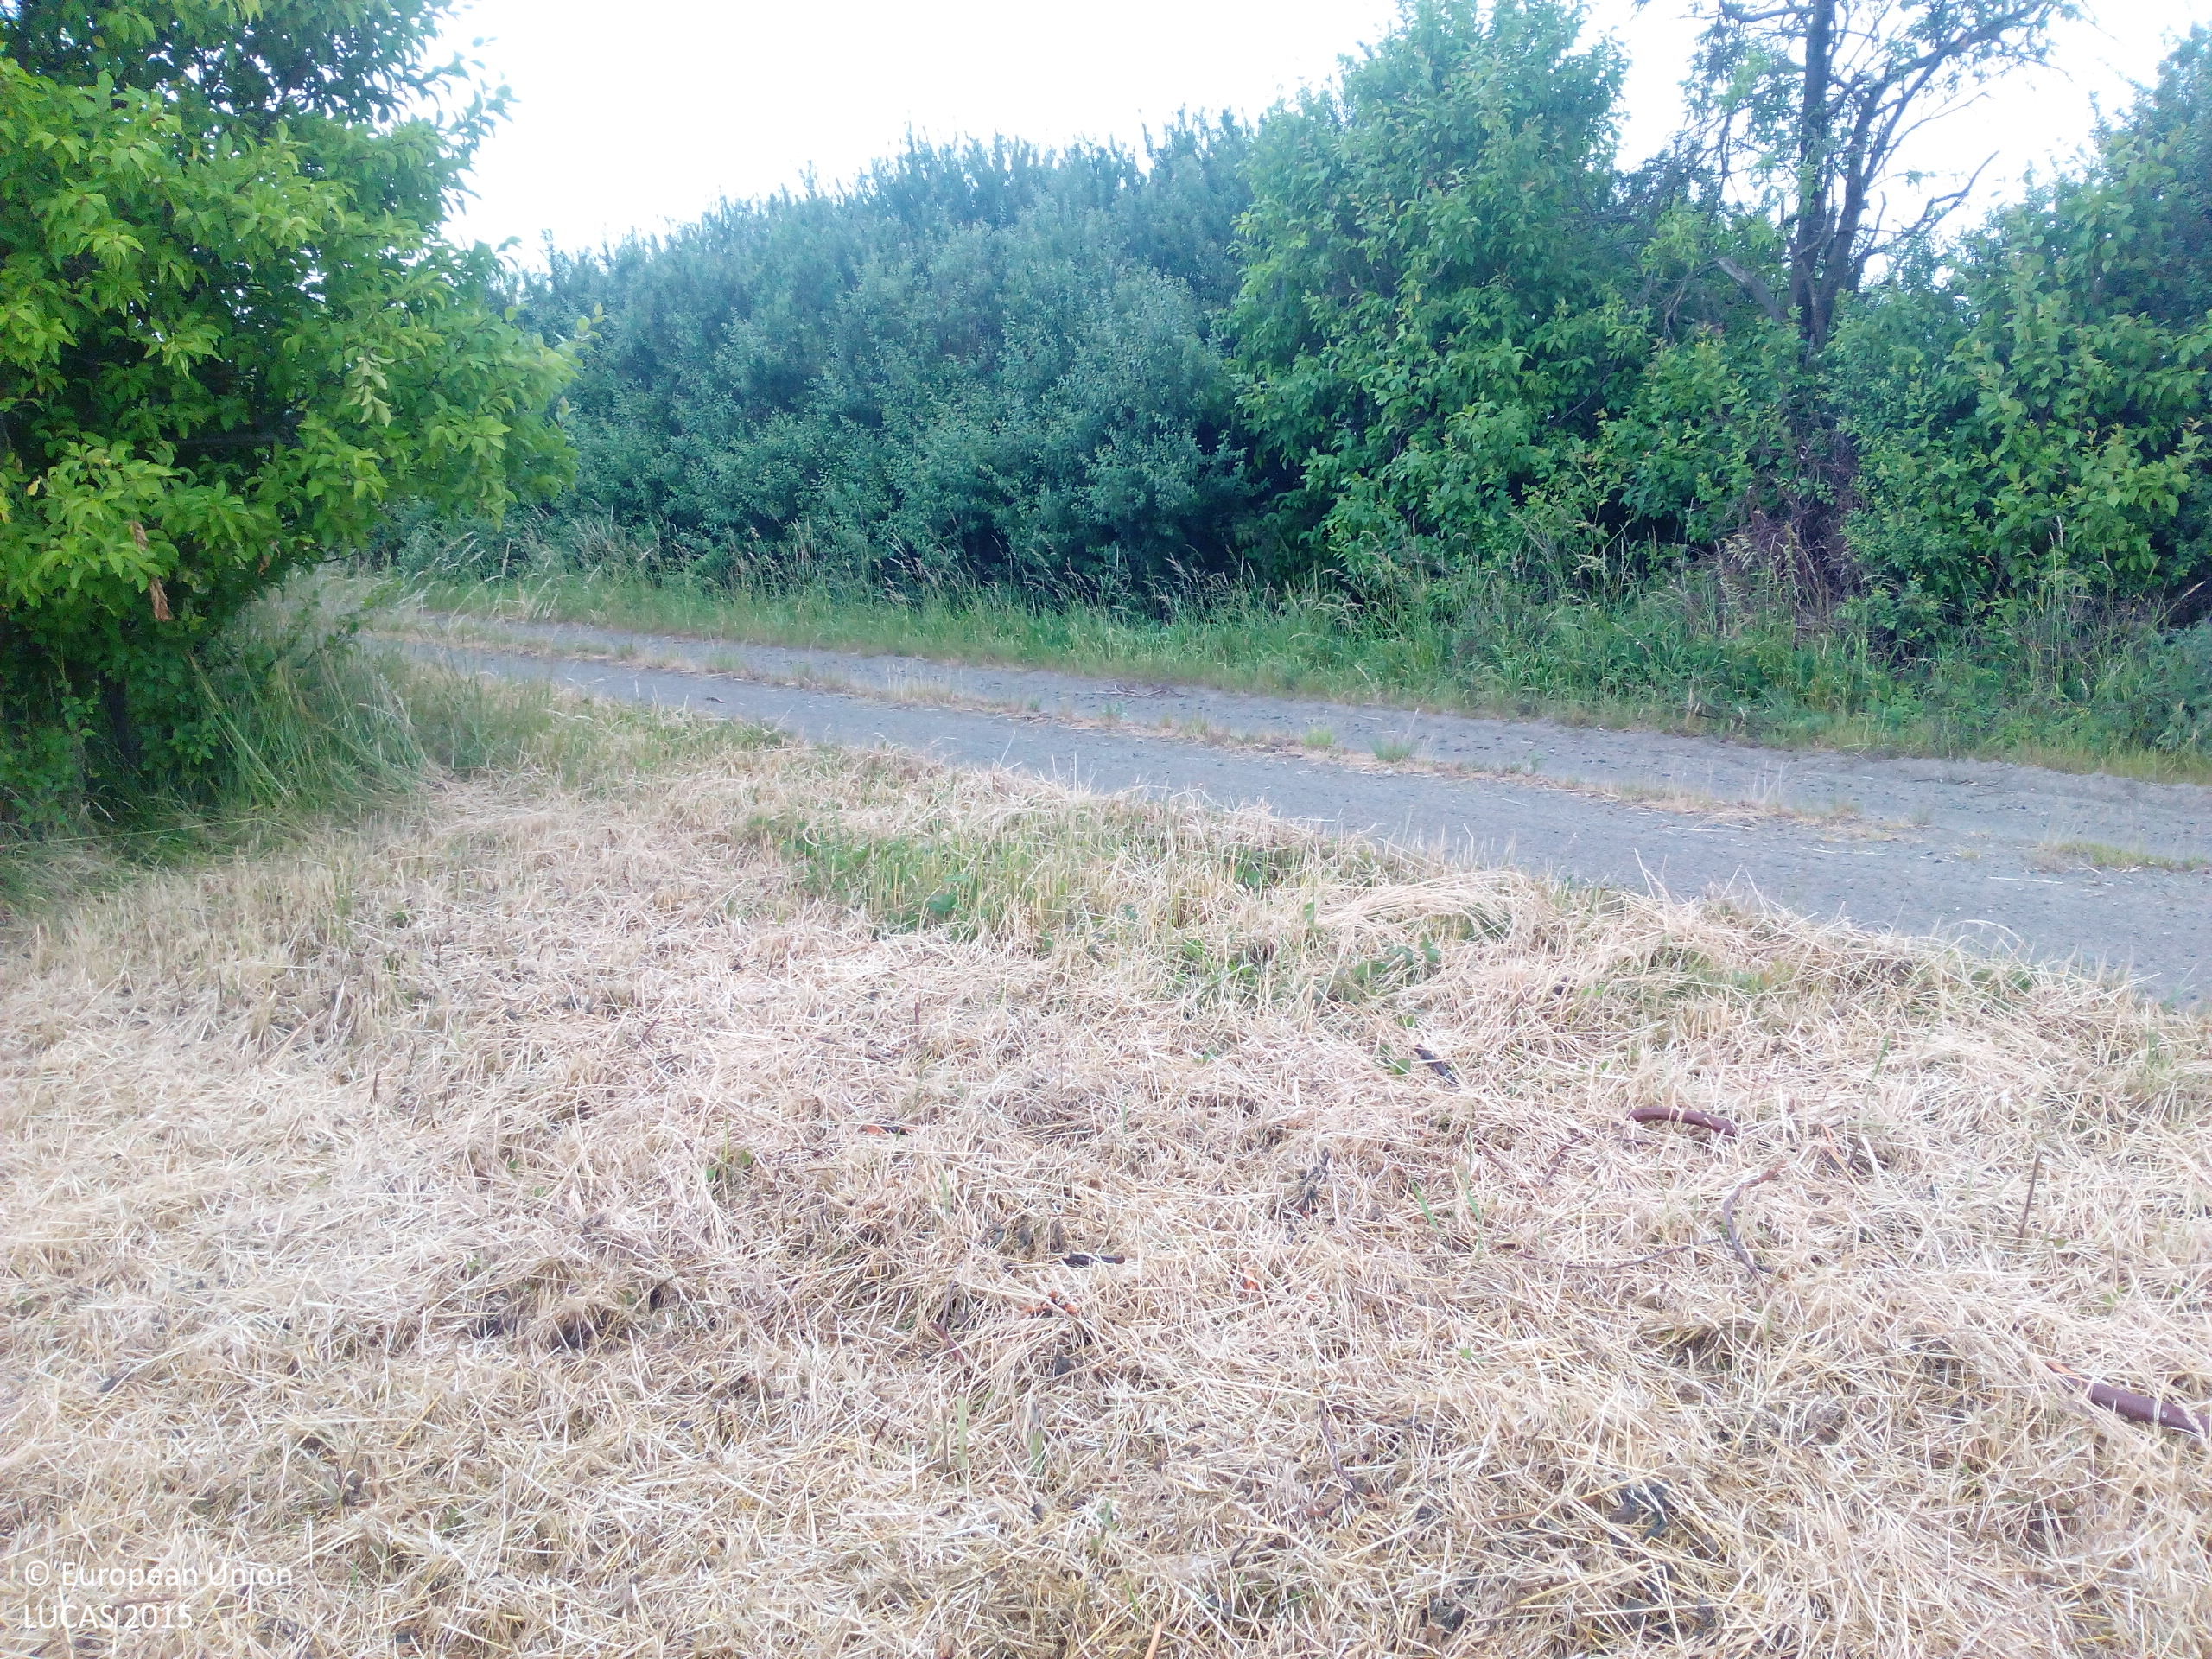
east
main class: Cropland
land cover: Rape and turnip rape
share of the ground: > 75 %
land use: Agriculture (excluding fallow land and kitchen gardens)
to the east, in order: Rape and turnip rape; Shrubland with sparse tree cover; Tracks; Shrubland with sparse tree cover; Sugar beet
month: June
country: DE
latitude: 52.3361
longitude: 11.1297
